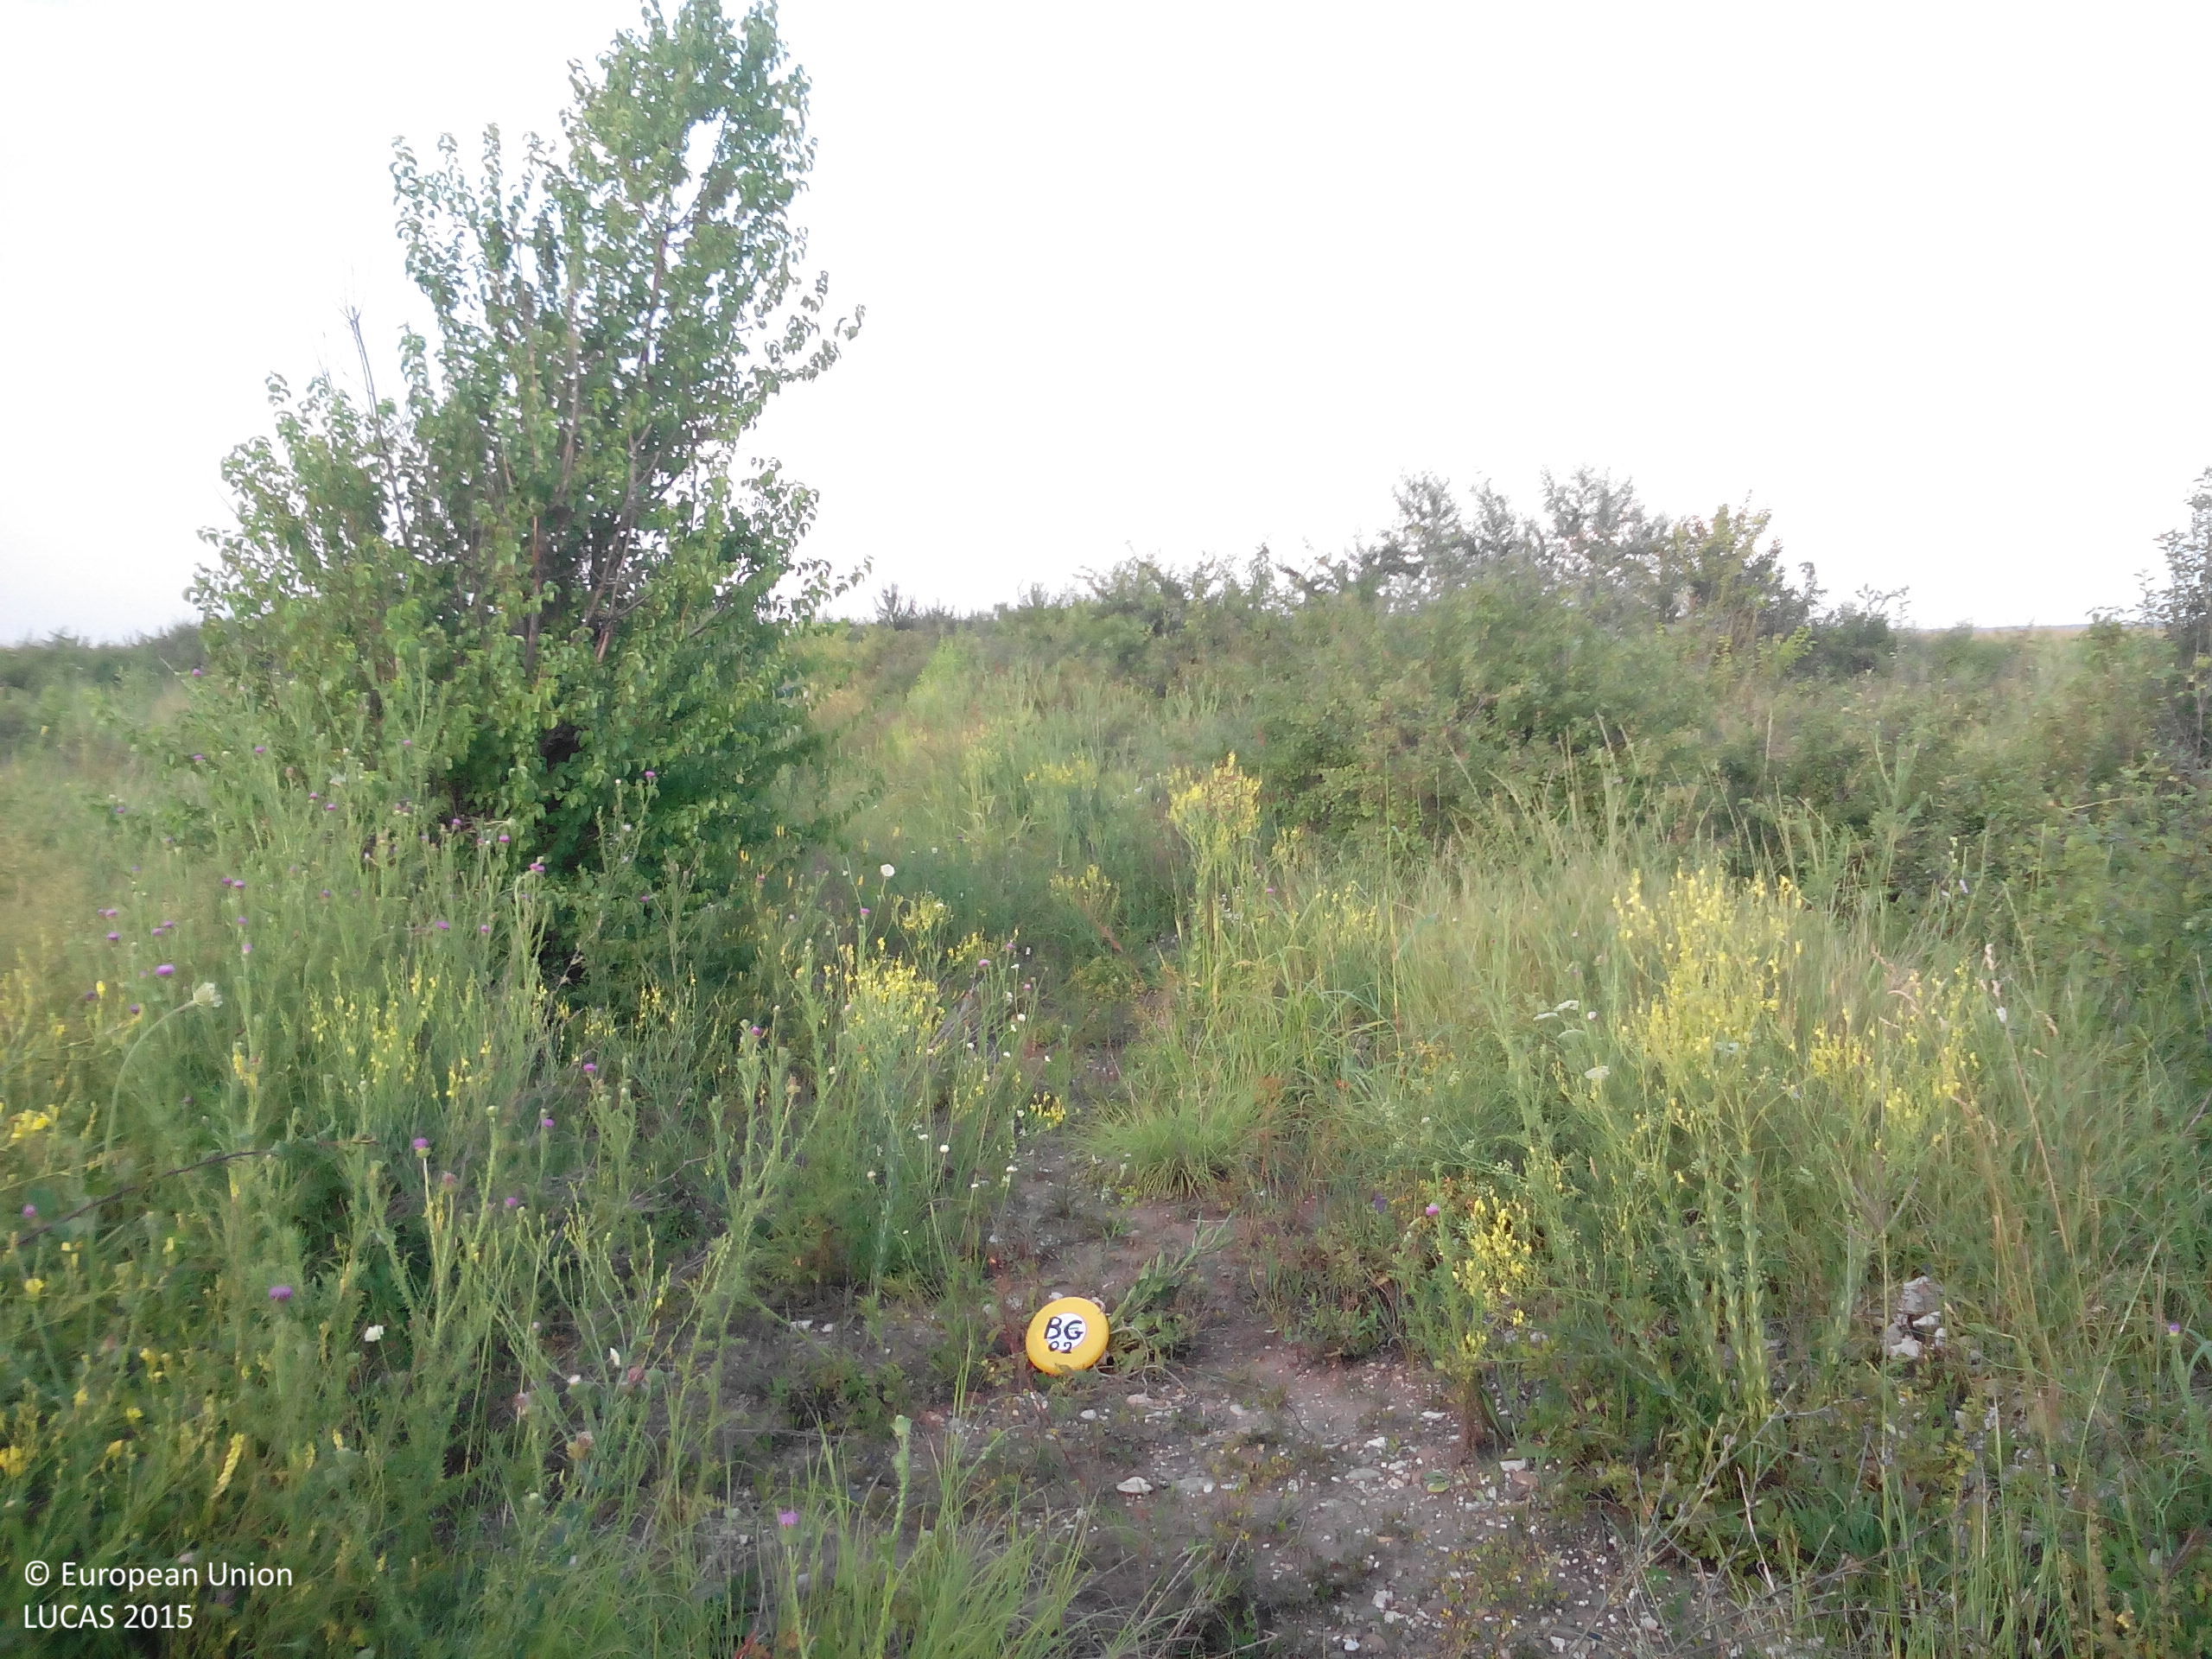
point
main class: Shrubland
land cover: Shrubland with sparse tree cover
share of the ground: > 75 %
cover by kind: shrubs 90 %, broadleaved forest trees 5 %, herbaceous plants 5 %
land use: Abandoned areas
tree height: < 5 m
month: July
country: BG
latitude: 43.3451
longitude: 24.1037
